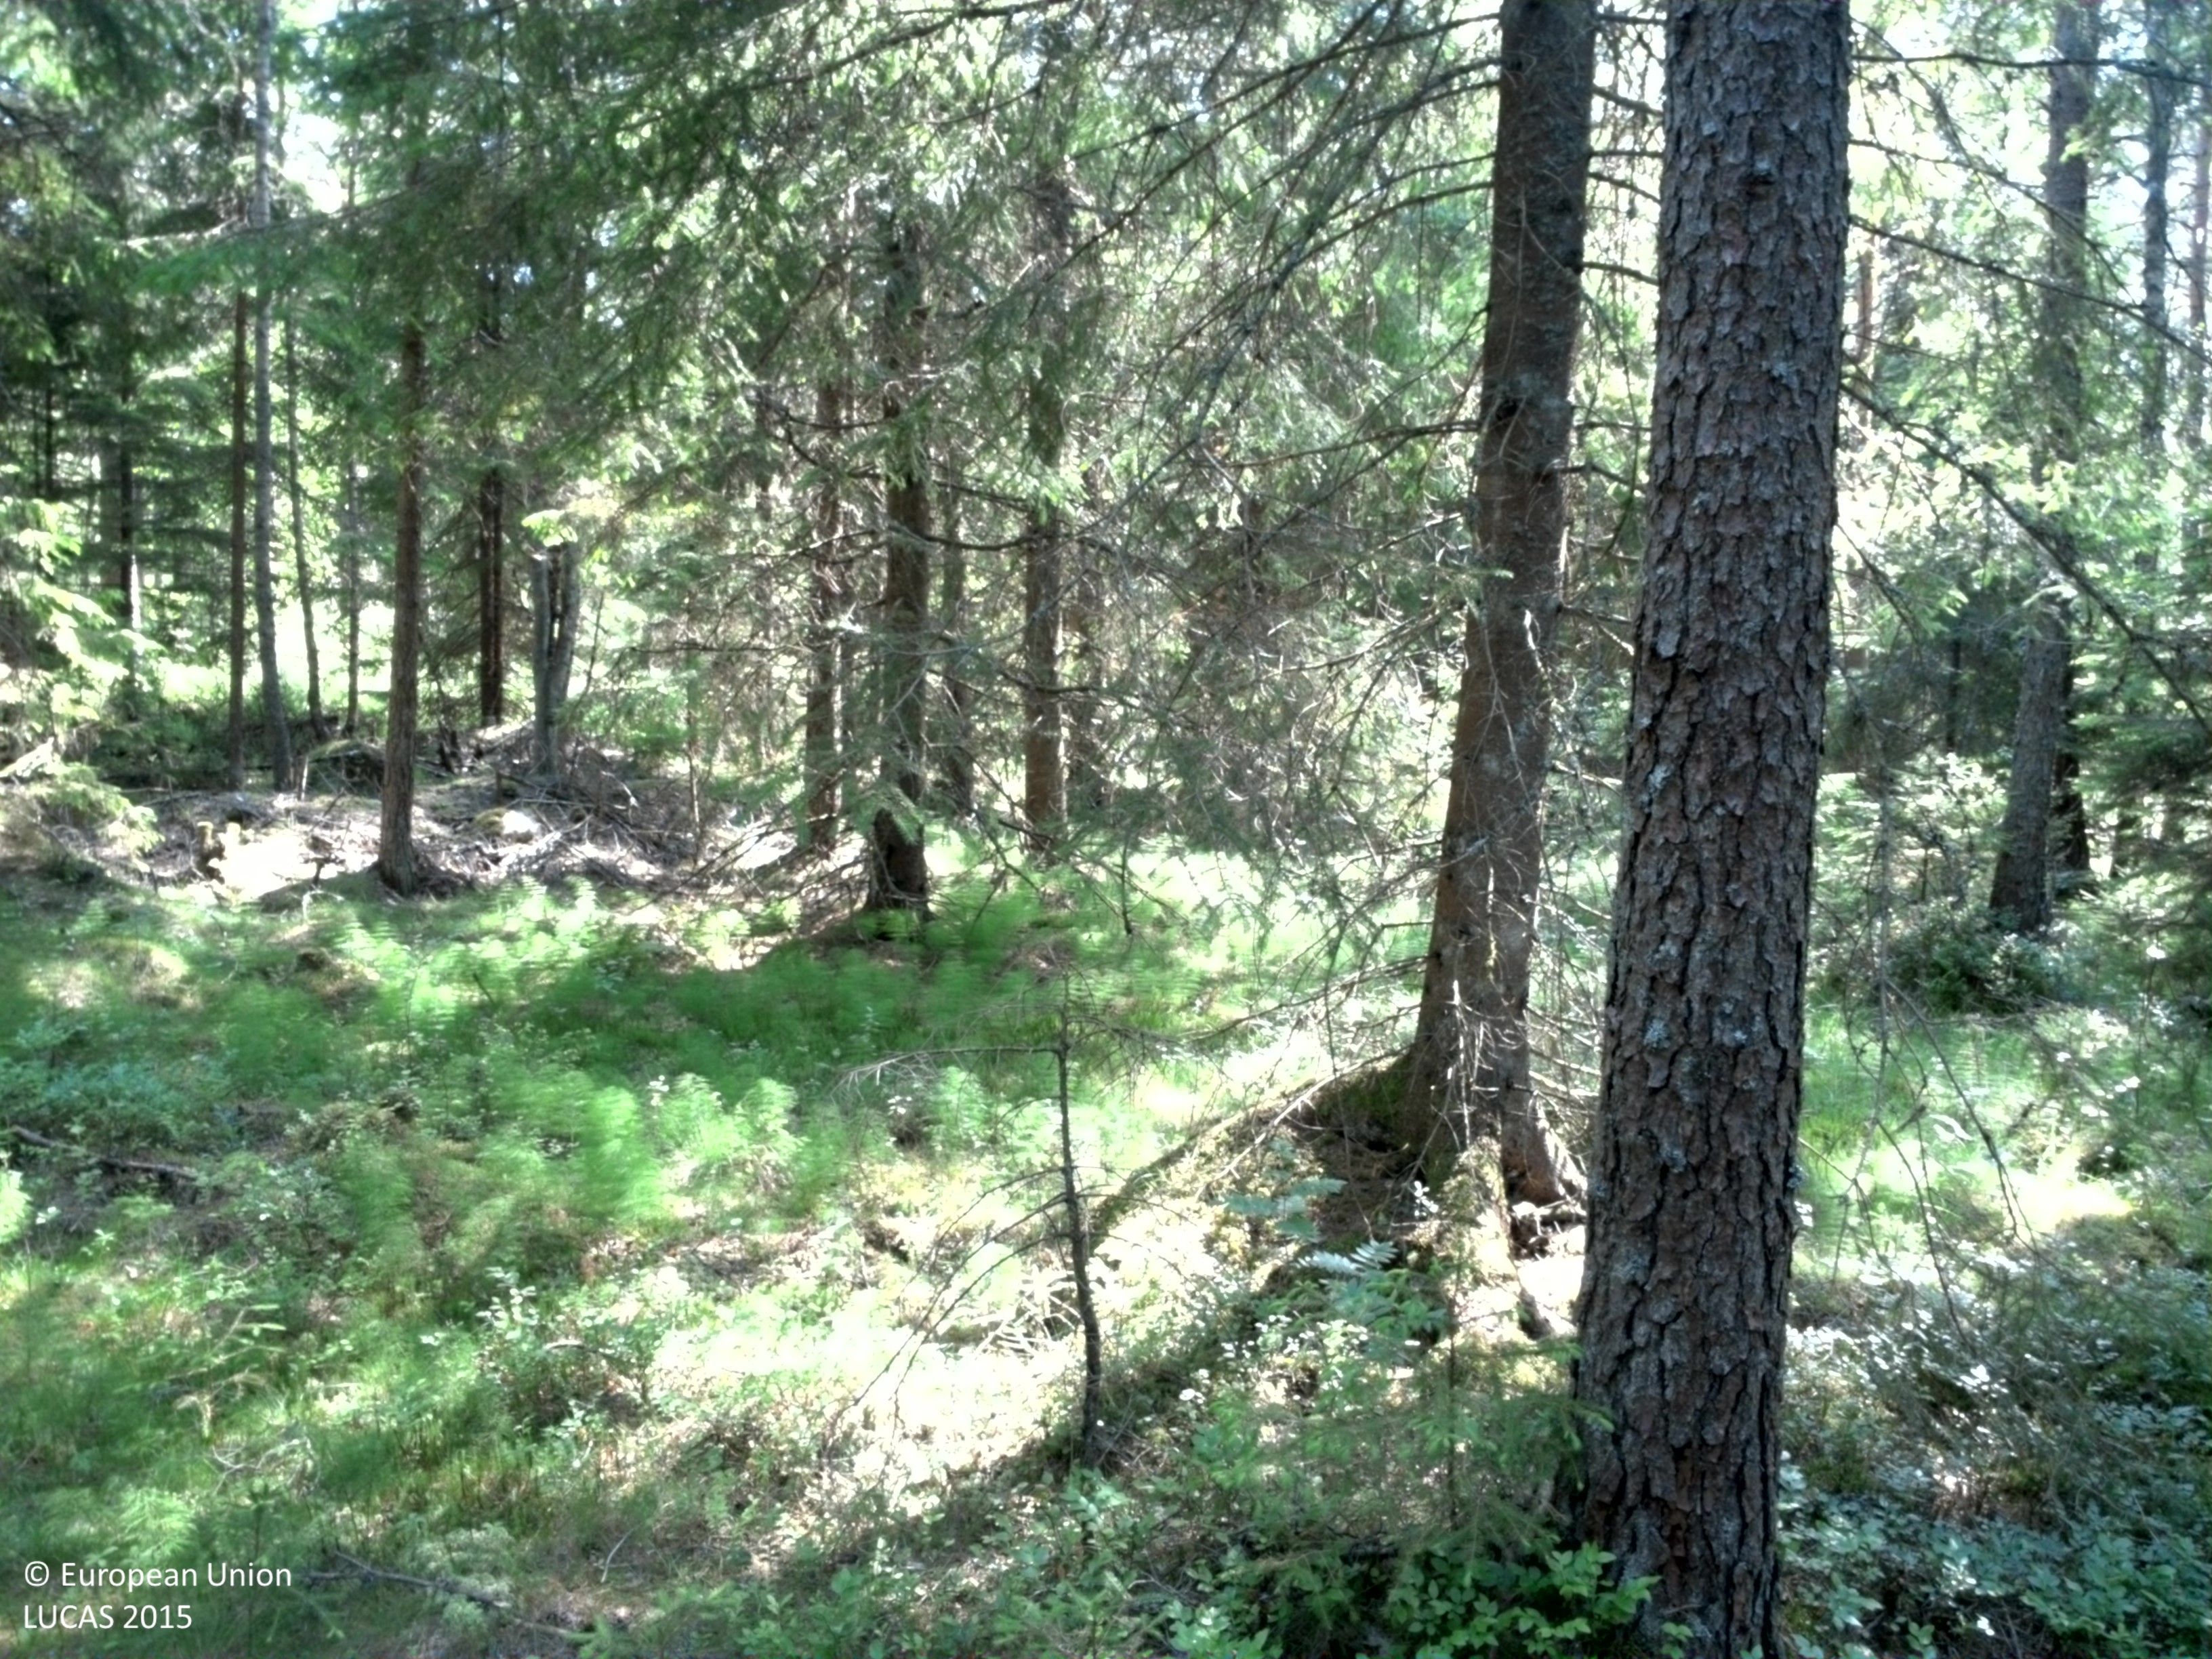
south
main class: Woodland
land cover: Spruce dominated coniferous woodland
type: boreal forest
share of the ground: 50 - 75 %
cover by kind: coniferous forest trees 70 %, shrubs 10 %, lichens and mosses 10 %, broadleaved forest trees 5 %, herbaceous plants 5 %
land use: Forestry
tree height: > 5 m
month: July
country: SE
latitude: 57.6219
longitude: 13.9299
